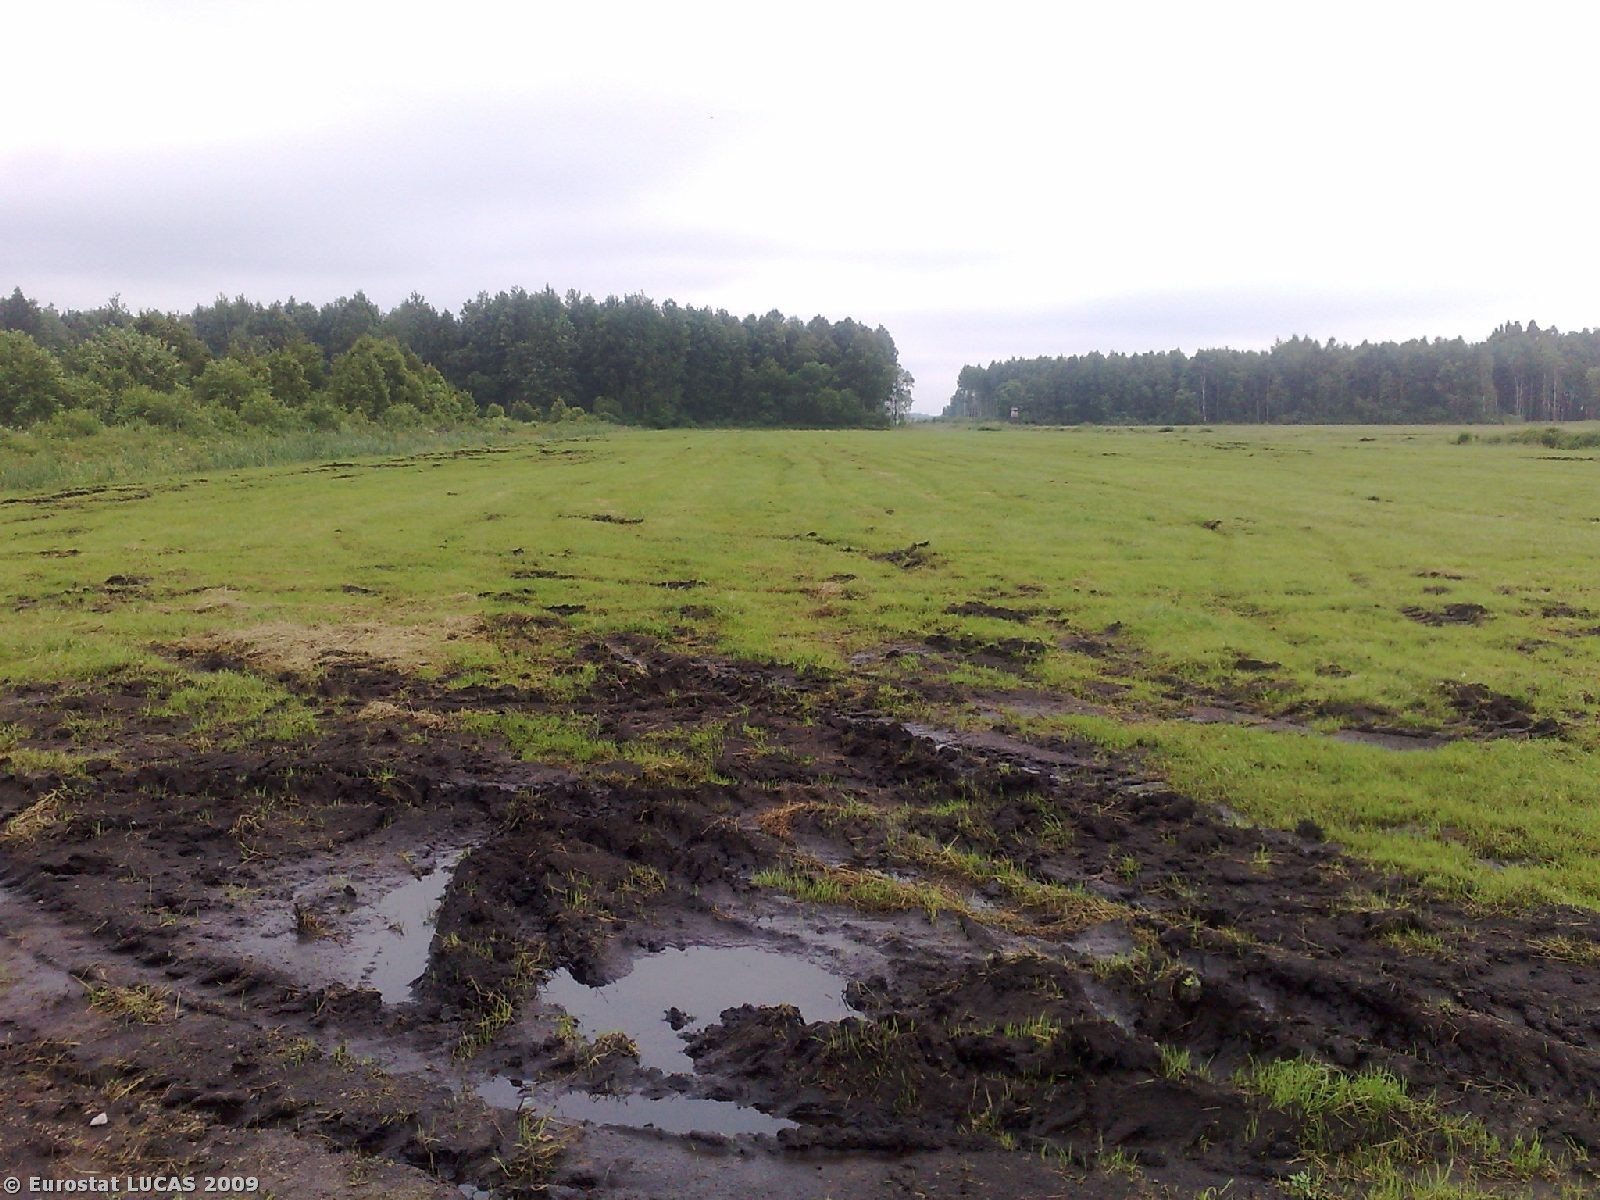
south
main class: Grassland
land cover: Grassland without tree/shrub cover
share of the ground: > 75 %
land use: Agriculture (excluding fallow land and kitchen gardens)
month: June
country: PL
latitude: 53.7251
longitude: 23.4344
